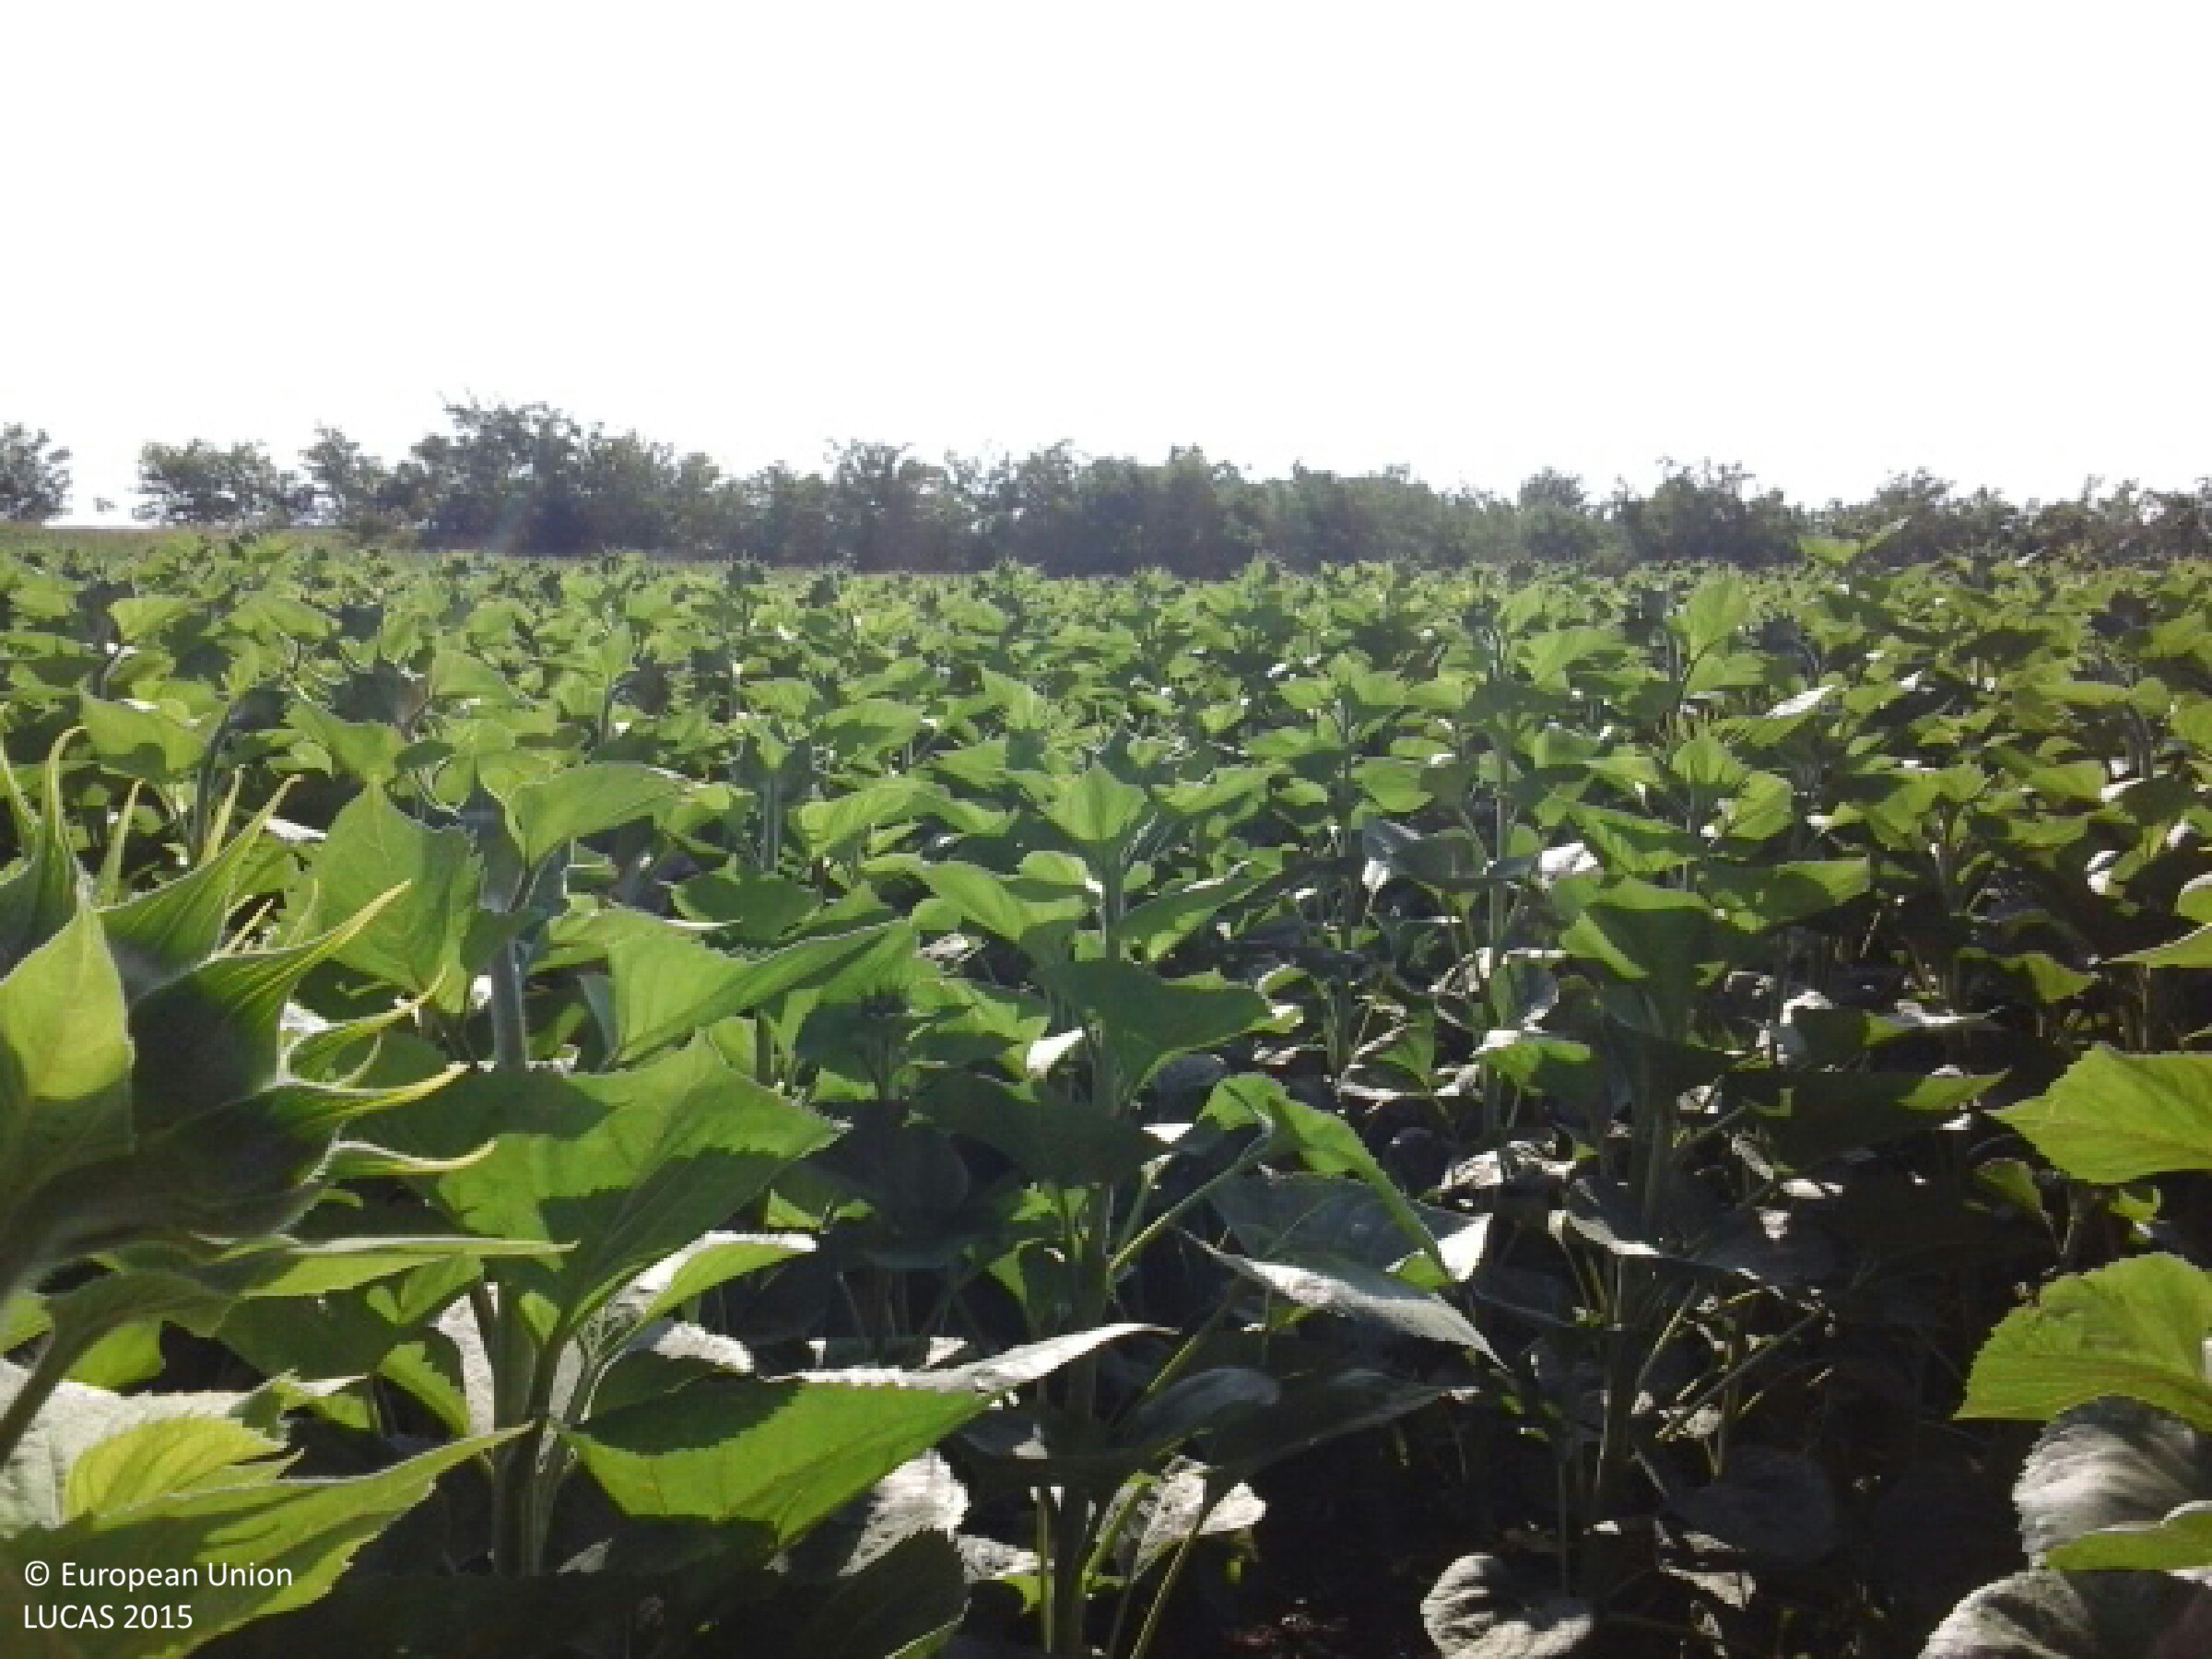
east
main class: Cropland
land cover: Sunflower
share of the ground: > 75 %
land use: Agriculture (excluding fallow land and kitchen gardens)
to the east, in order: Sunflower; Broadleaved woodland; Tracks; Broadleaved woodland; Triticale
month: June
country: HU
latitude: 48.0334
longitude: 21.5392
